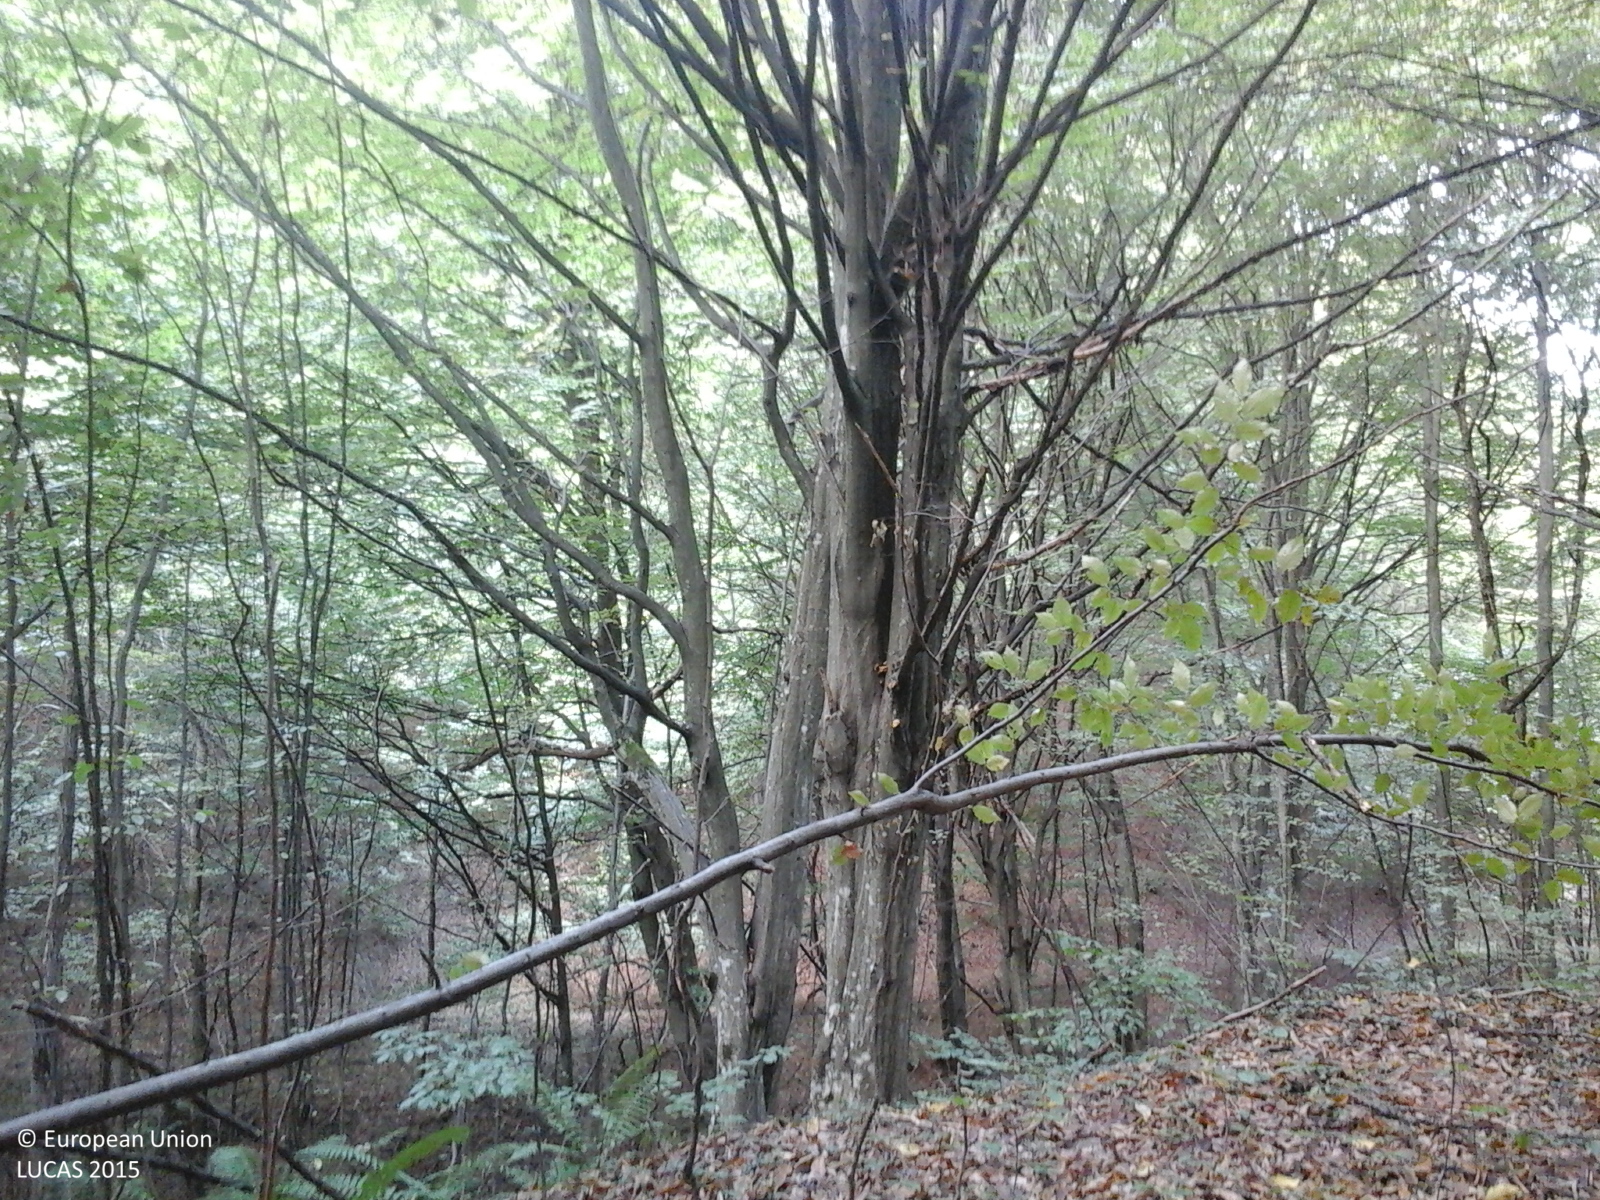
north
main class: Woodland
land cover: Broadleaved woodland
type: beech forest
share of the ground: > 75 %
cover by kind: broadleaved forest trees 100 %
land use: Forestry
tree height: > 5 m
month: September
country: RO
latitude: 45.3812
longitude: 22.0041
